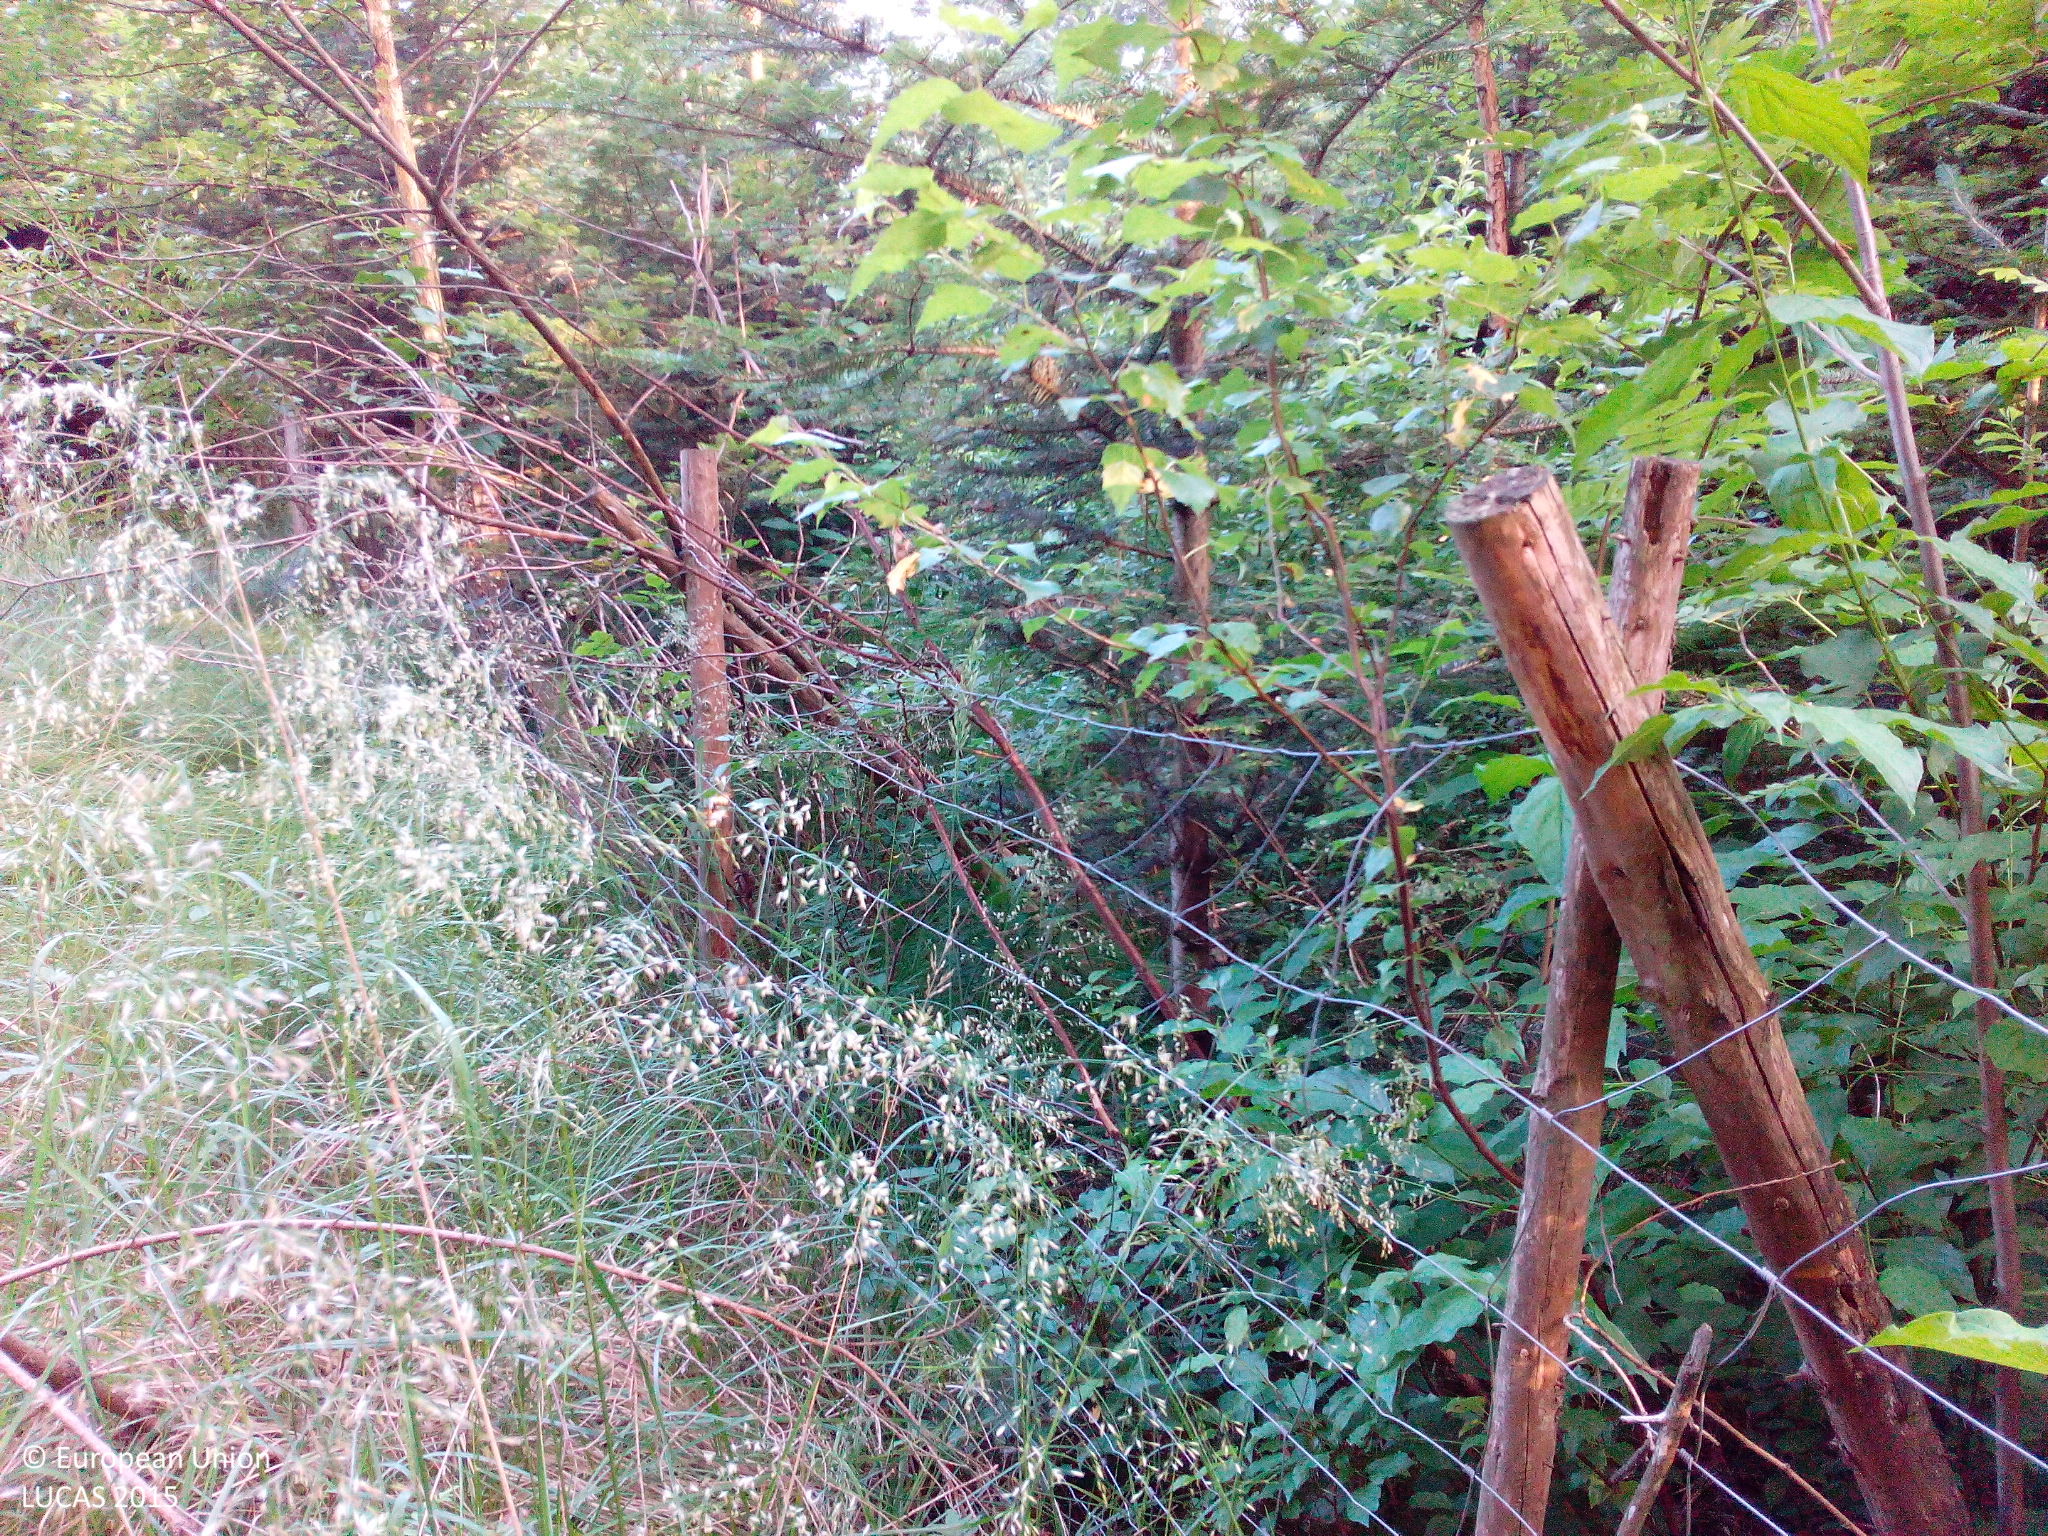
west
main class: Woodland
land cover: Spruce dominated coniferous woodland
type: hemiboreal forest and nemoral coniferous forest and mixed broadleaved-coniferous forest
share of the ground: > 75 %
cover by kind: coniferous forest trees 85 %, shrubs 15 %
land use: Forestry
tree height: > 5 m
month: July
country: DE
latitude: 48.9037
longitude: 10.8864
